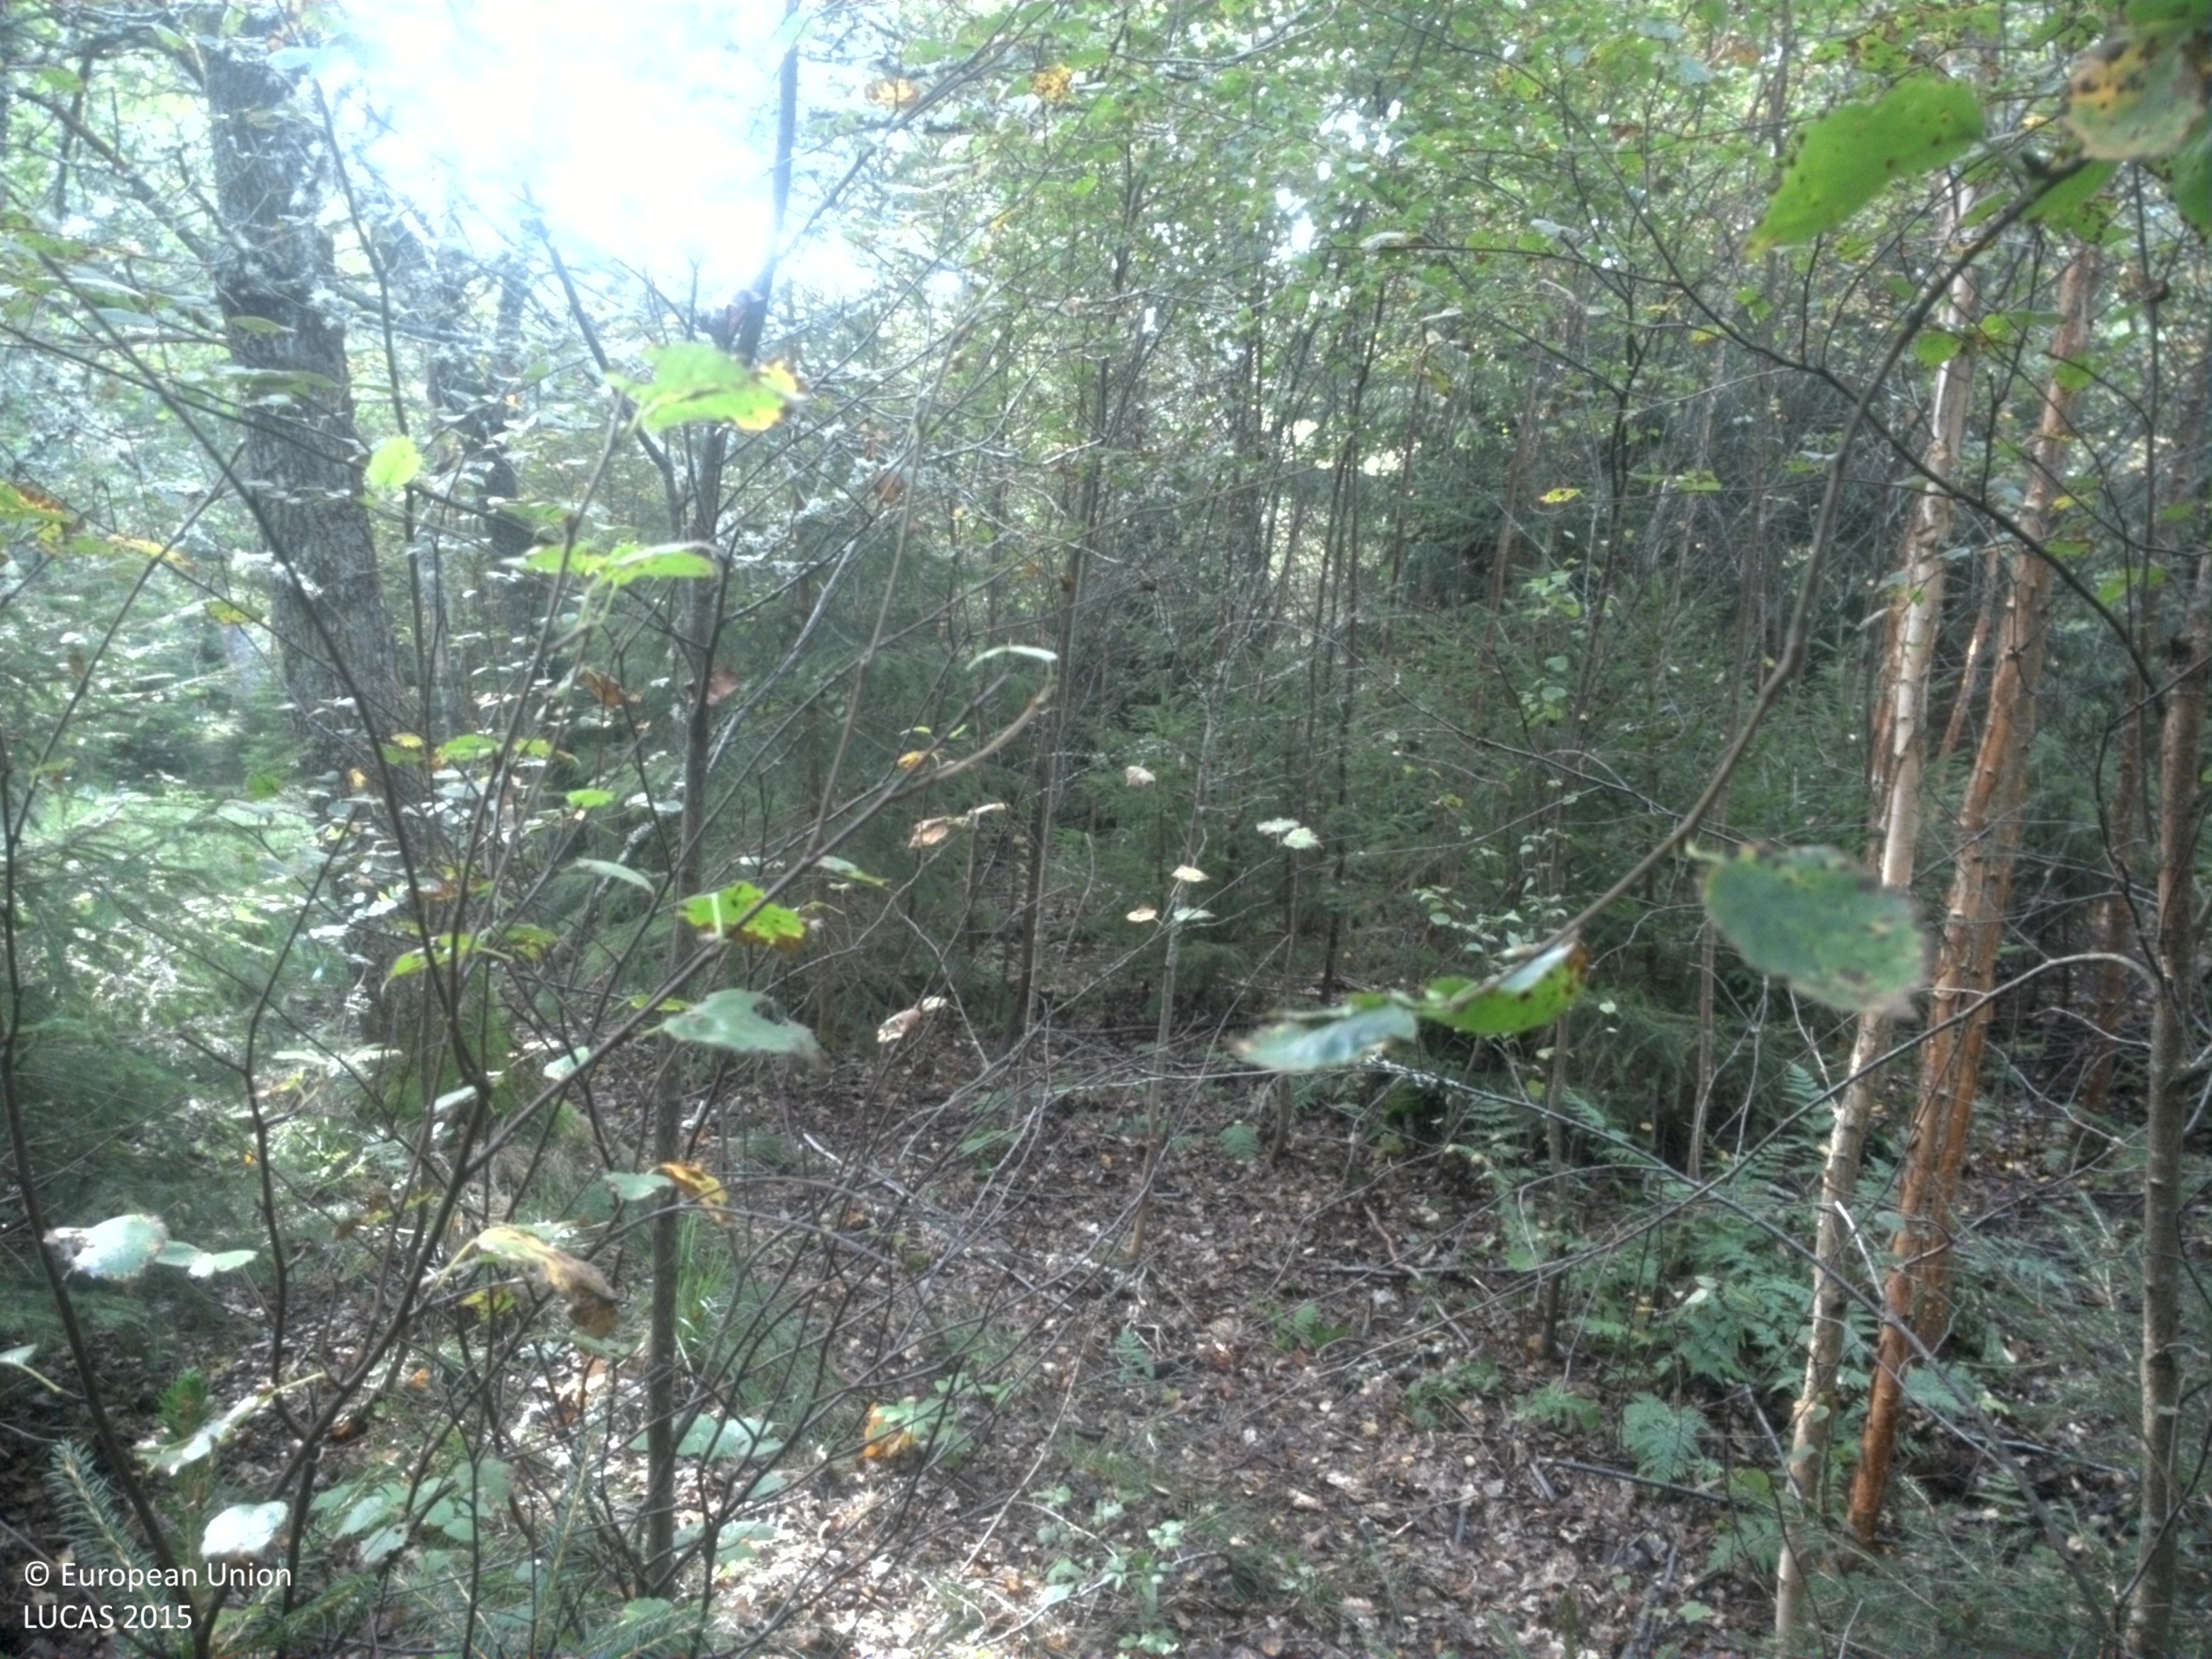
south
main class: Woodland
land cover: Spruce dominated mixed woodland
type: boreal forest
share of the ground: > 75 %
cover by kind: broadleaved forest trees 50 %, coniferous forest trees 25 %, unconsolidated bare surface 10 %, shrubs 5 %, herbaceous plants 5 %
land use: Forestry
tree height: > 5 m
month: September
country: SE
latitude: 59.5569
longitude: 15.7771
